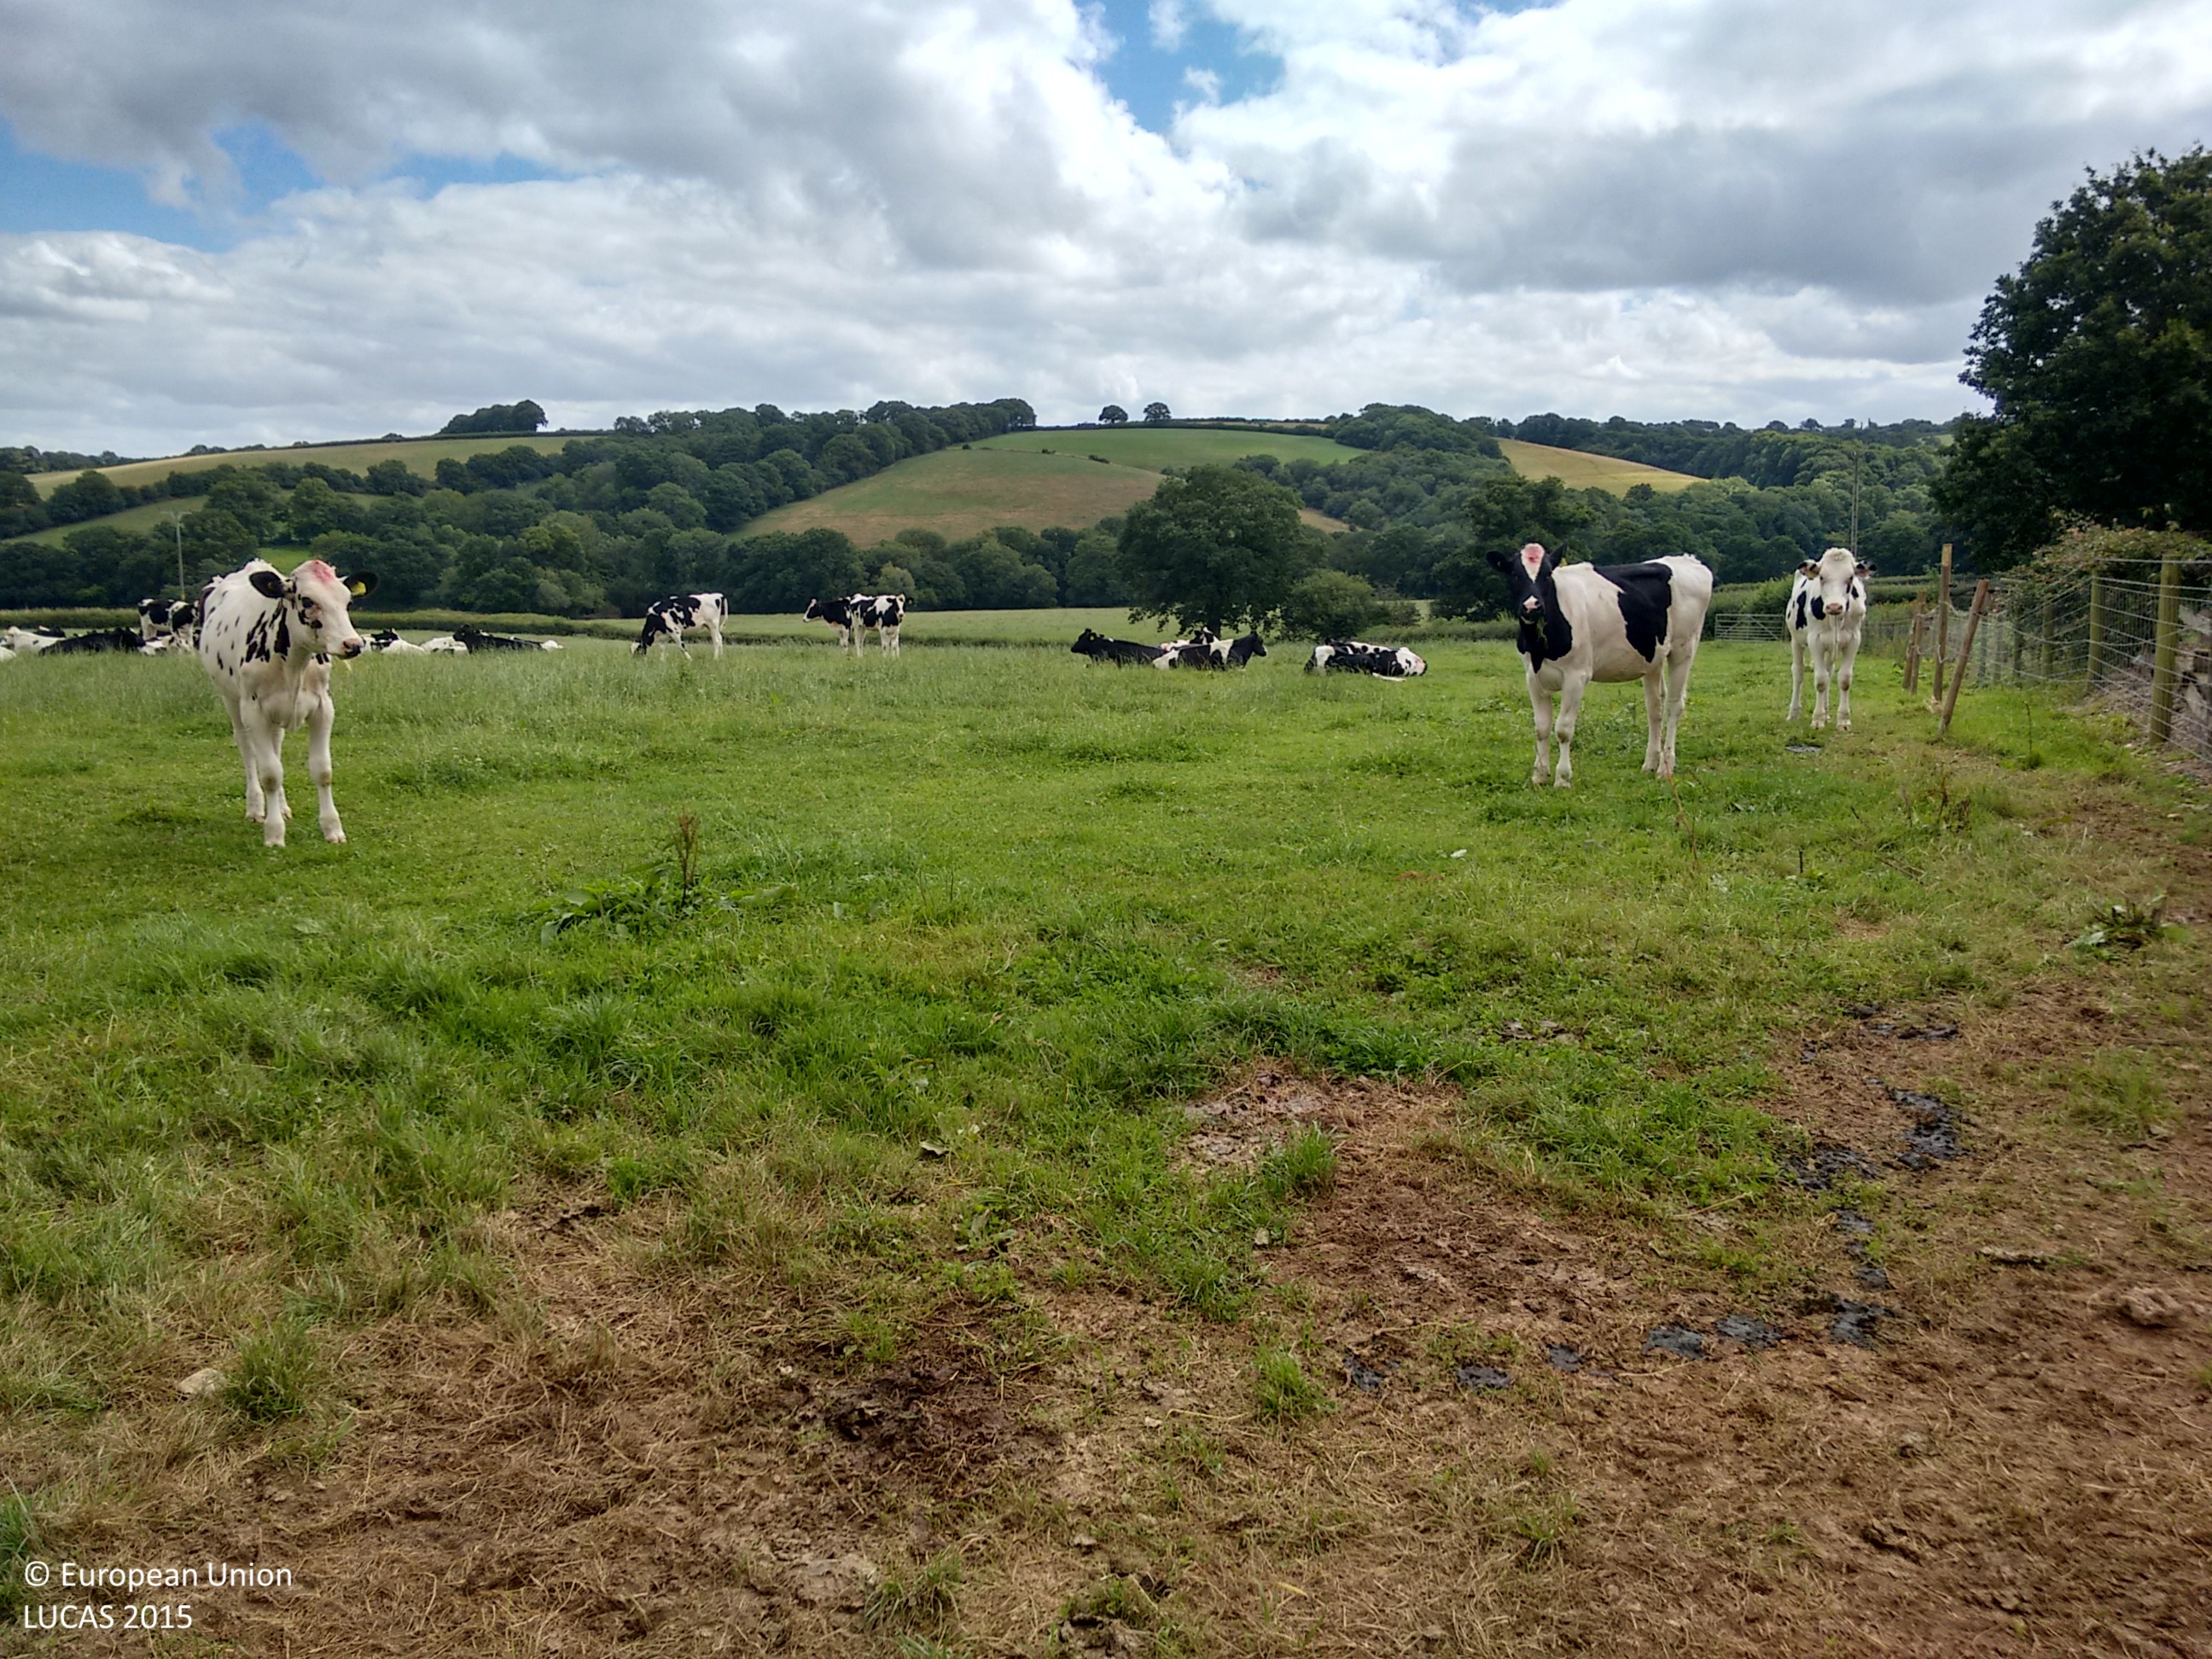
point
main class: Grassland
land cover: Grassland without tree/shrub cover
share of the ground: > 75 %
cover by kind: herbaceous plants 100 %
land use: Agriculture (excluding fallow land and kitchen gardens)
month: August
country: GB
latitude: 50.7701
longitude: -3.7437
